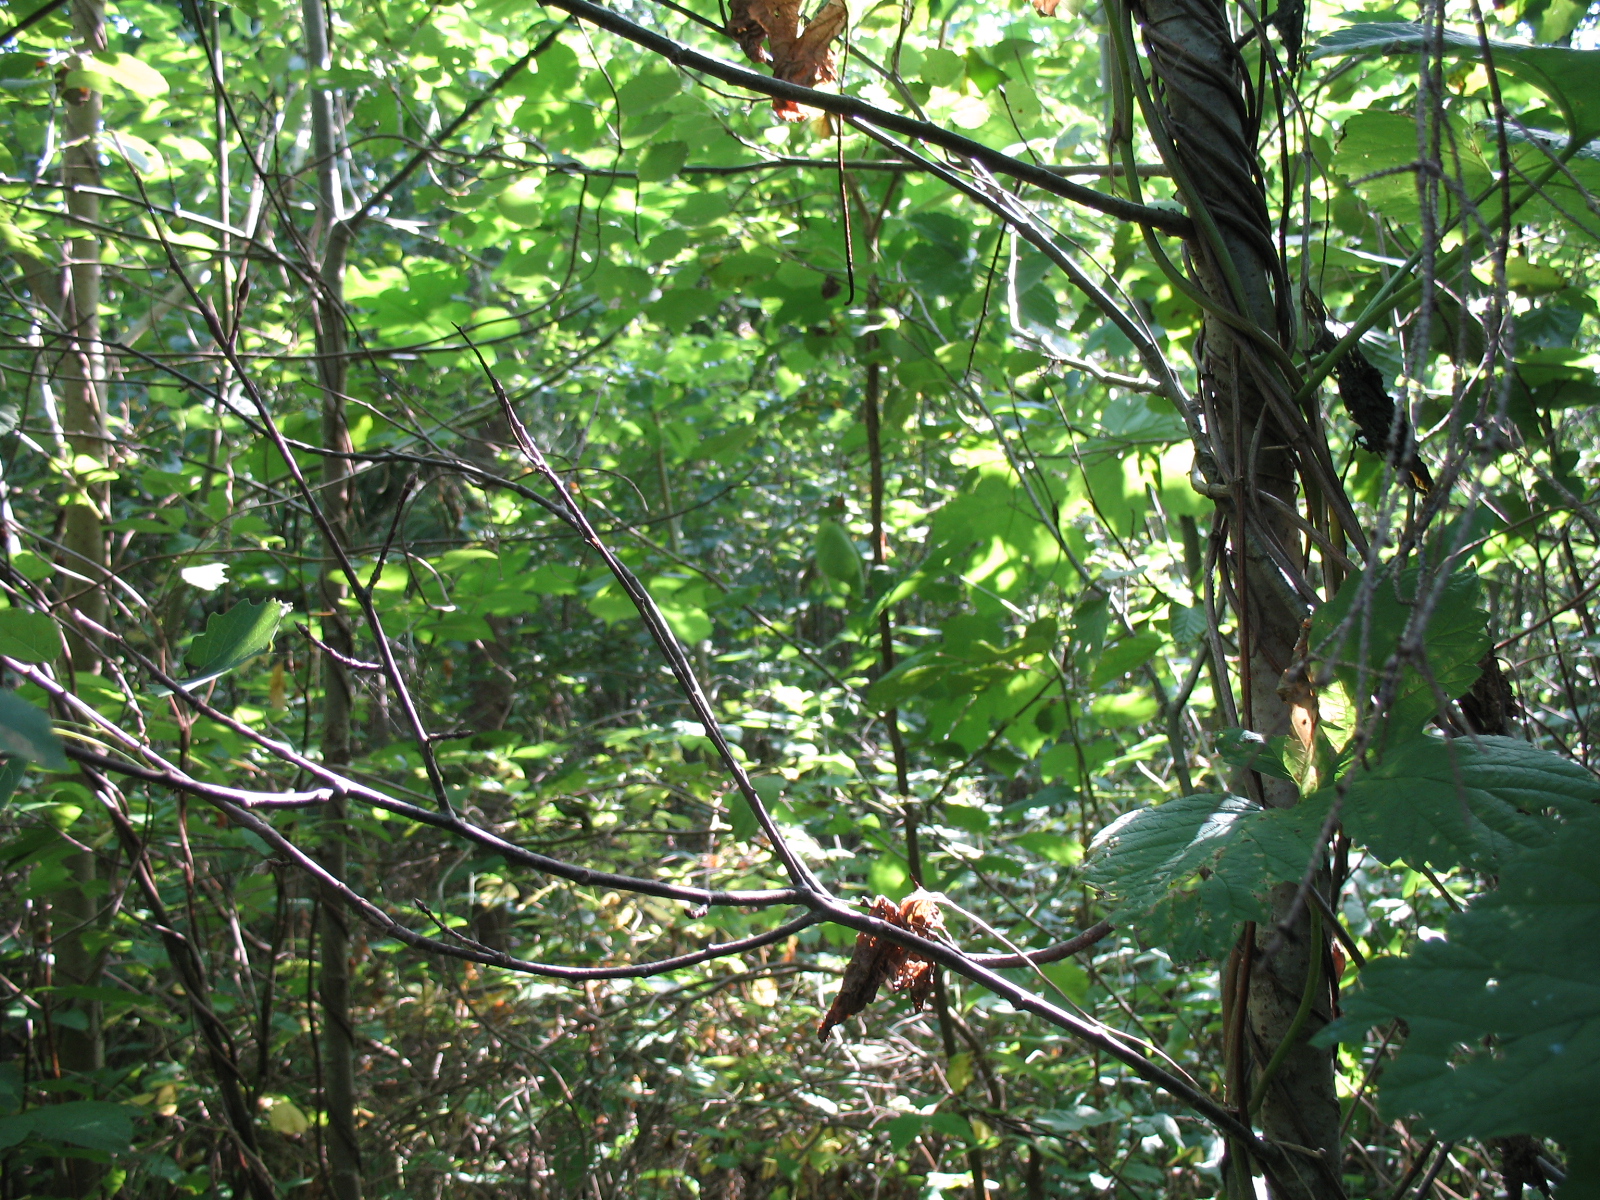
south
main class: Woodland
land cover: Spruce dominated mixed woodland
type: hemiboreal forest and nemoral coniferous forest and mixed broadleaved-coniferous forest
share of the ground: > 75 %
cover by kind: broadleaved forest trees 65 %, coniferous forest trees 30 %, herbaceous plants 5 %
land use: Forestry
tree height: > 5 m
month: August
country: LV
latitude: 56.2020
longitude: 25.4163
